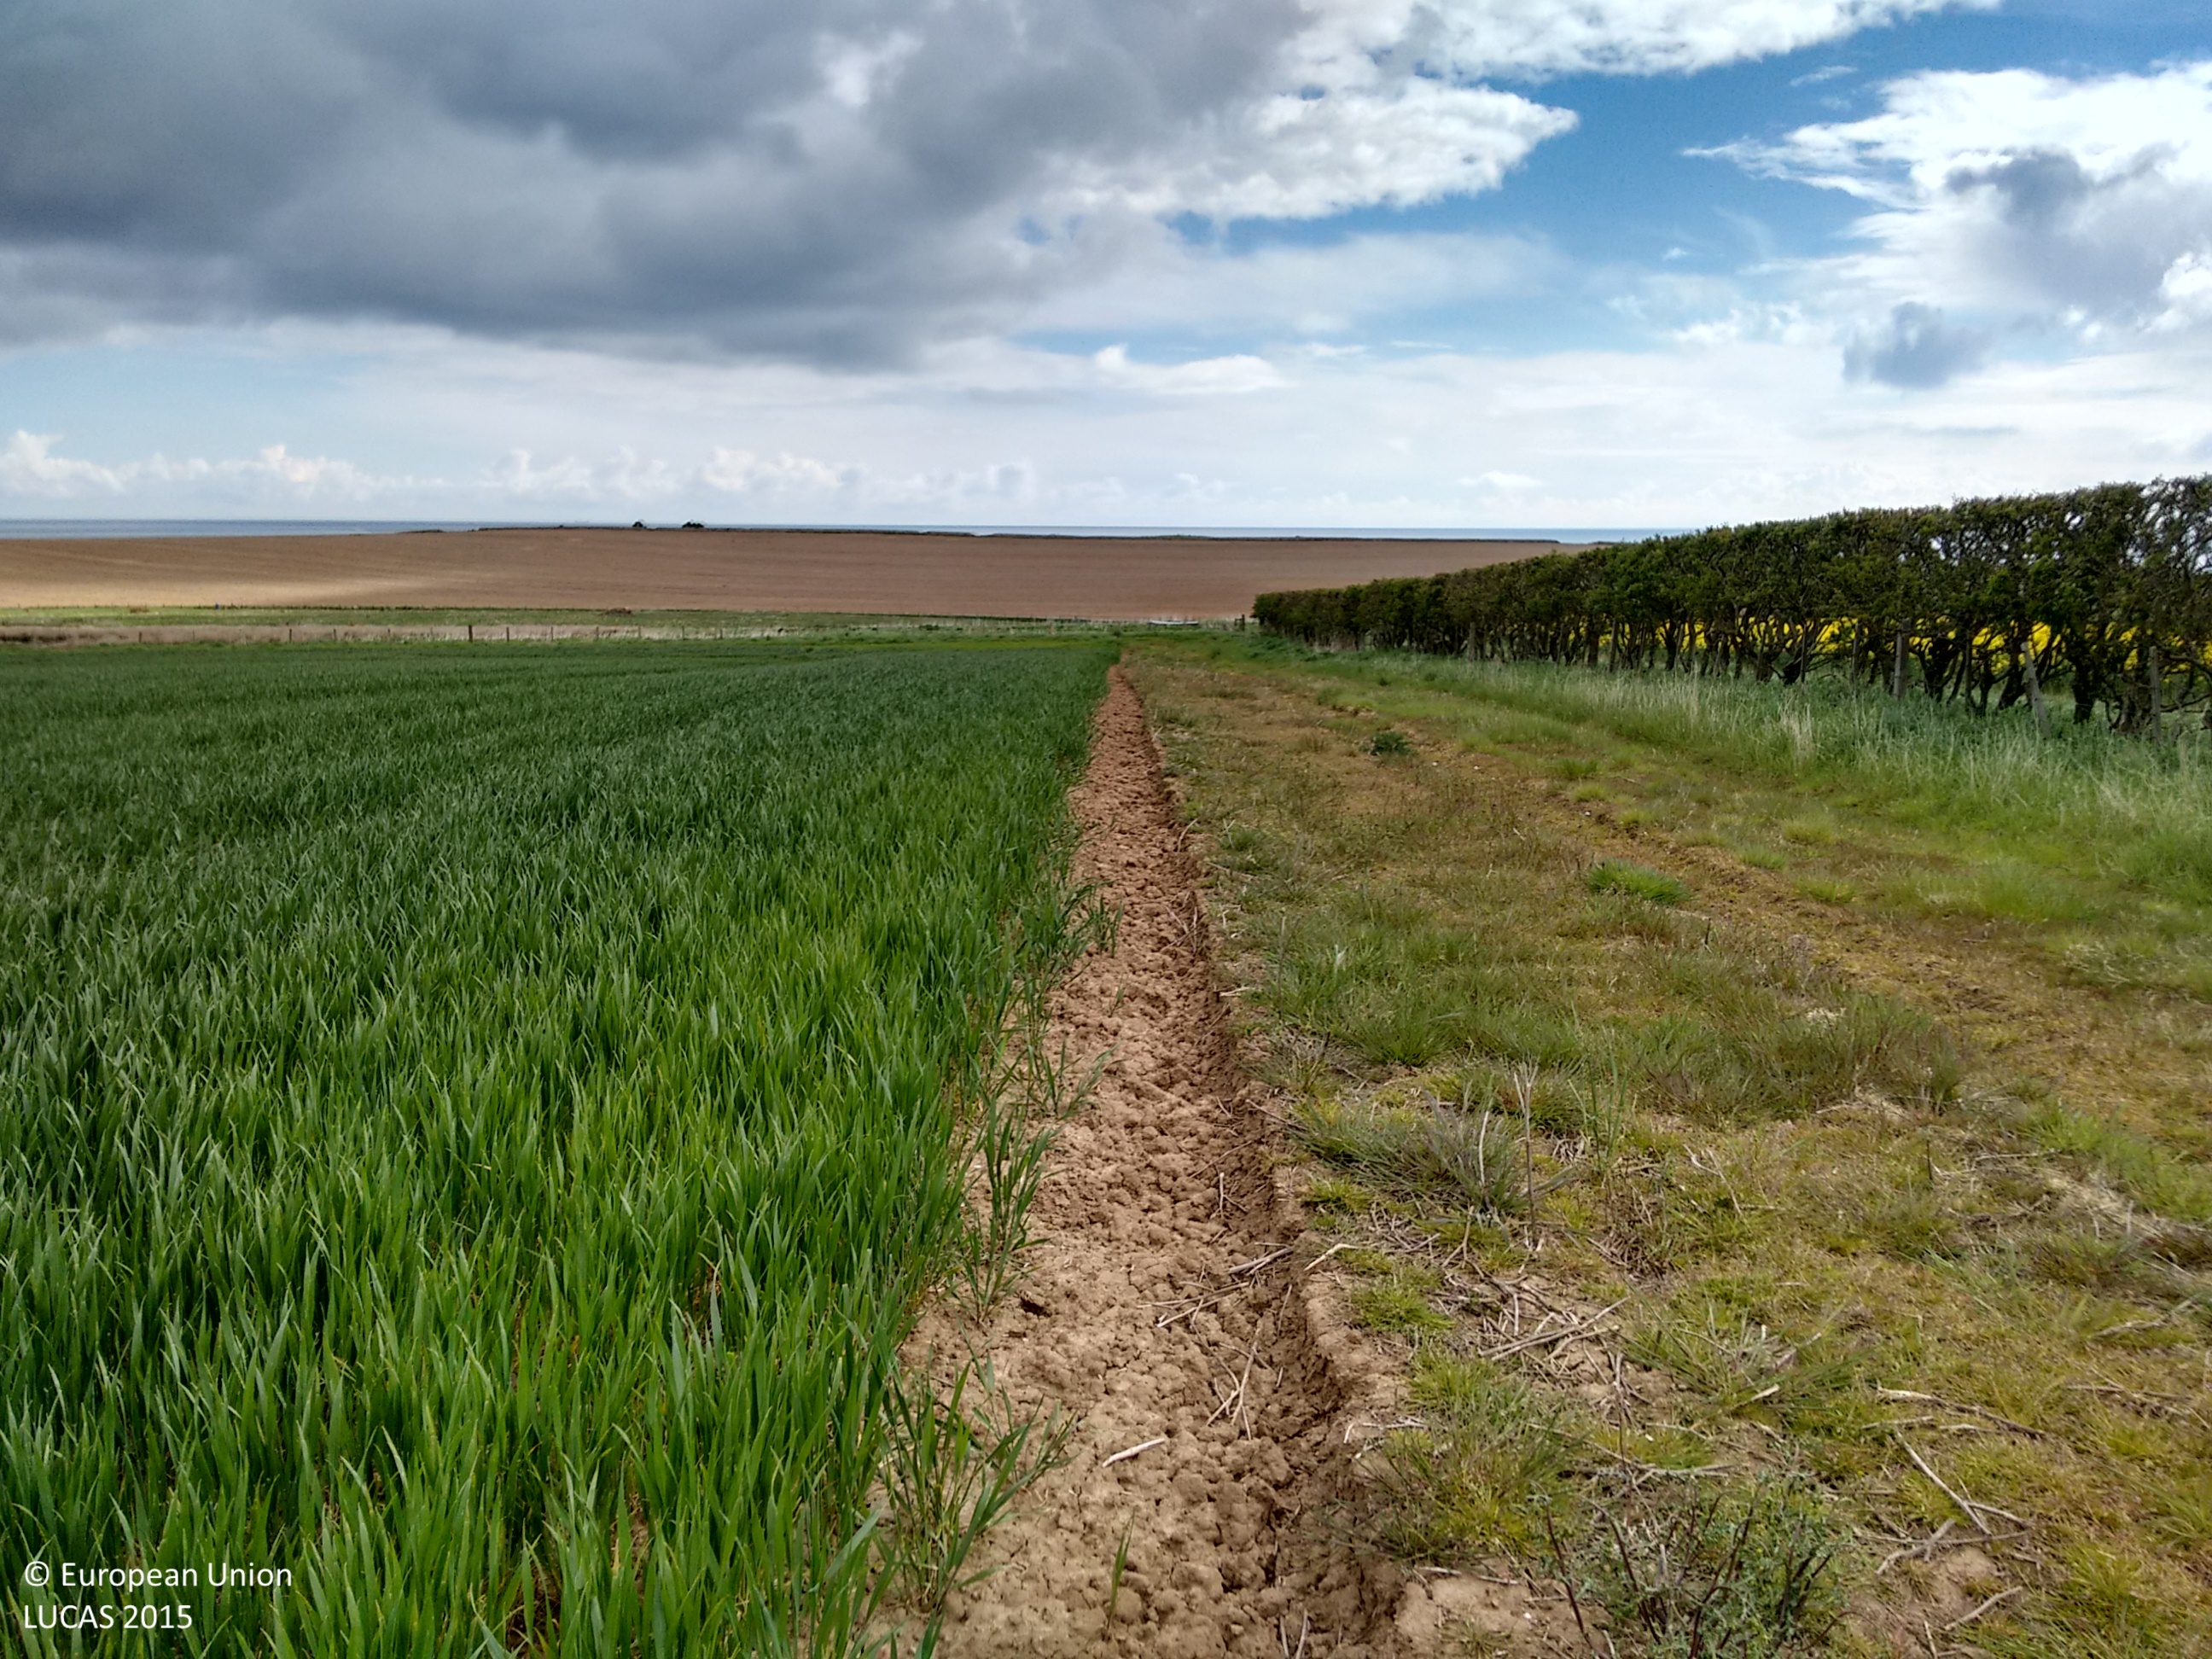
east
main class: Cropland
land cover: Common wheat
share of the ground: > 75 %
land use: Agriculture (excluding fallow land and kitchen gardens)
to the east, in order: Common wheat; Grassland without tree/shrub cover; Fences; Managed hedges; Grassland without tree/shrub cover; Rape and turnip rape; Grass margins; Abandoned hedges; Fences; Spontaneously vegetated surfaces; Fences; Grassland without tree/shrub cover; Common wheat
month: May
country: GB
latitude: 55.3675
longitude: -1.6128
